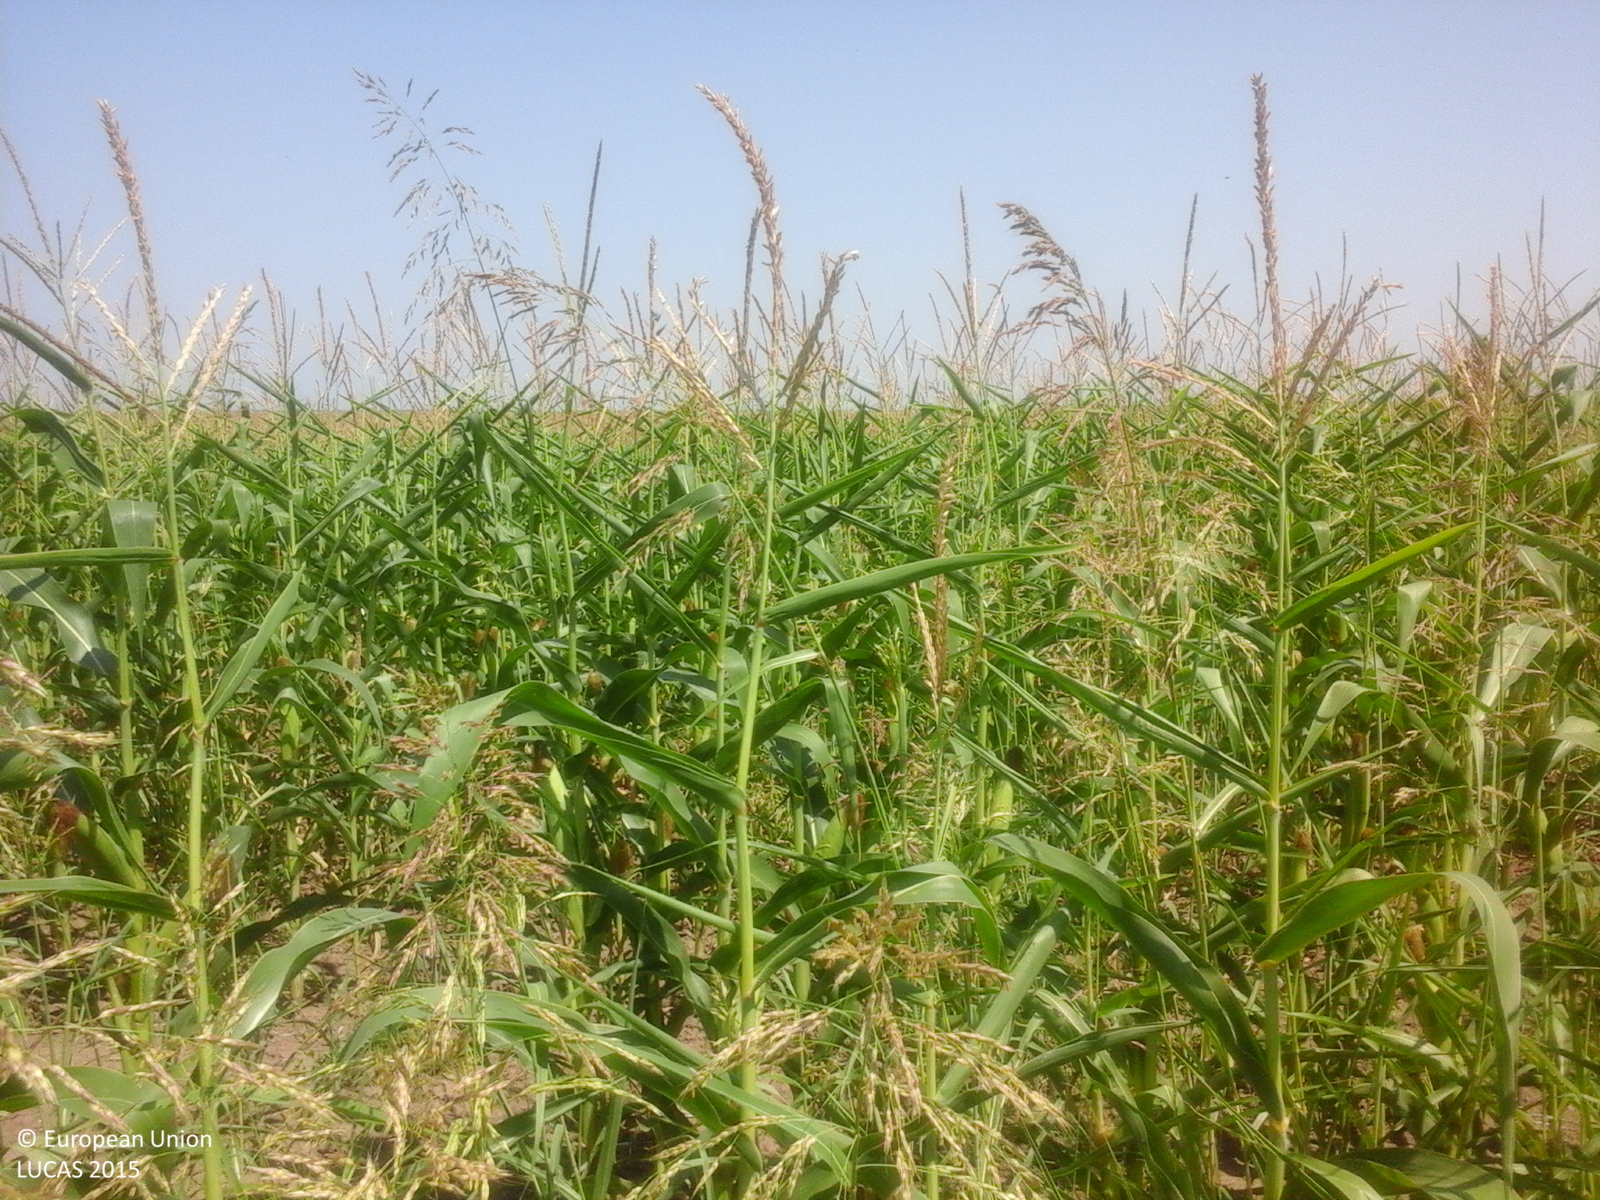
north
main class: Cropland
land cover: Maize
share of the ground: > 75 %
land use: Agriculture (excluding fallow land and kitchen gardens)
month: July
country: RO
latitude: 44.4665
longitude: 26.7517
